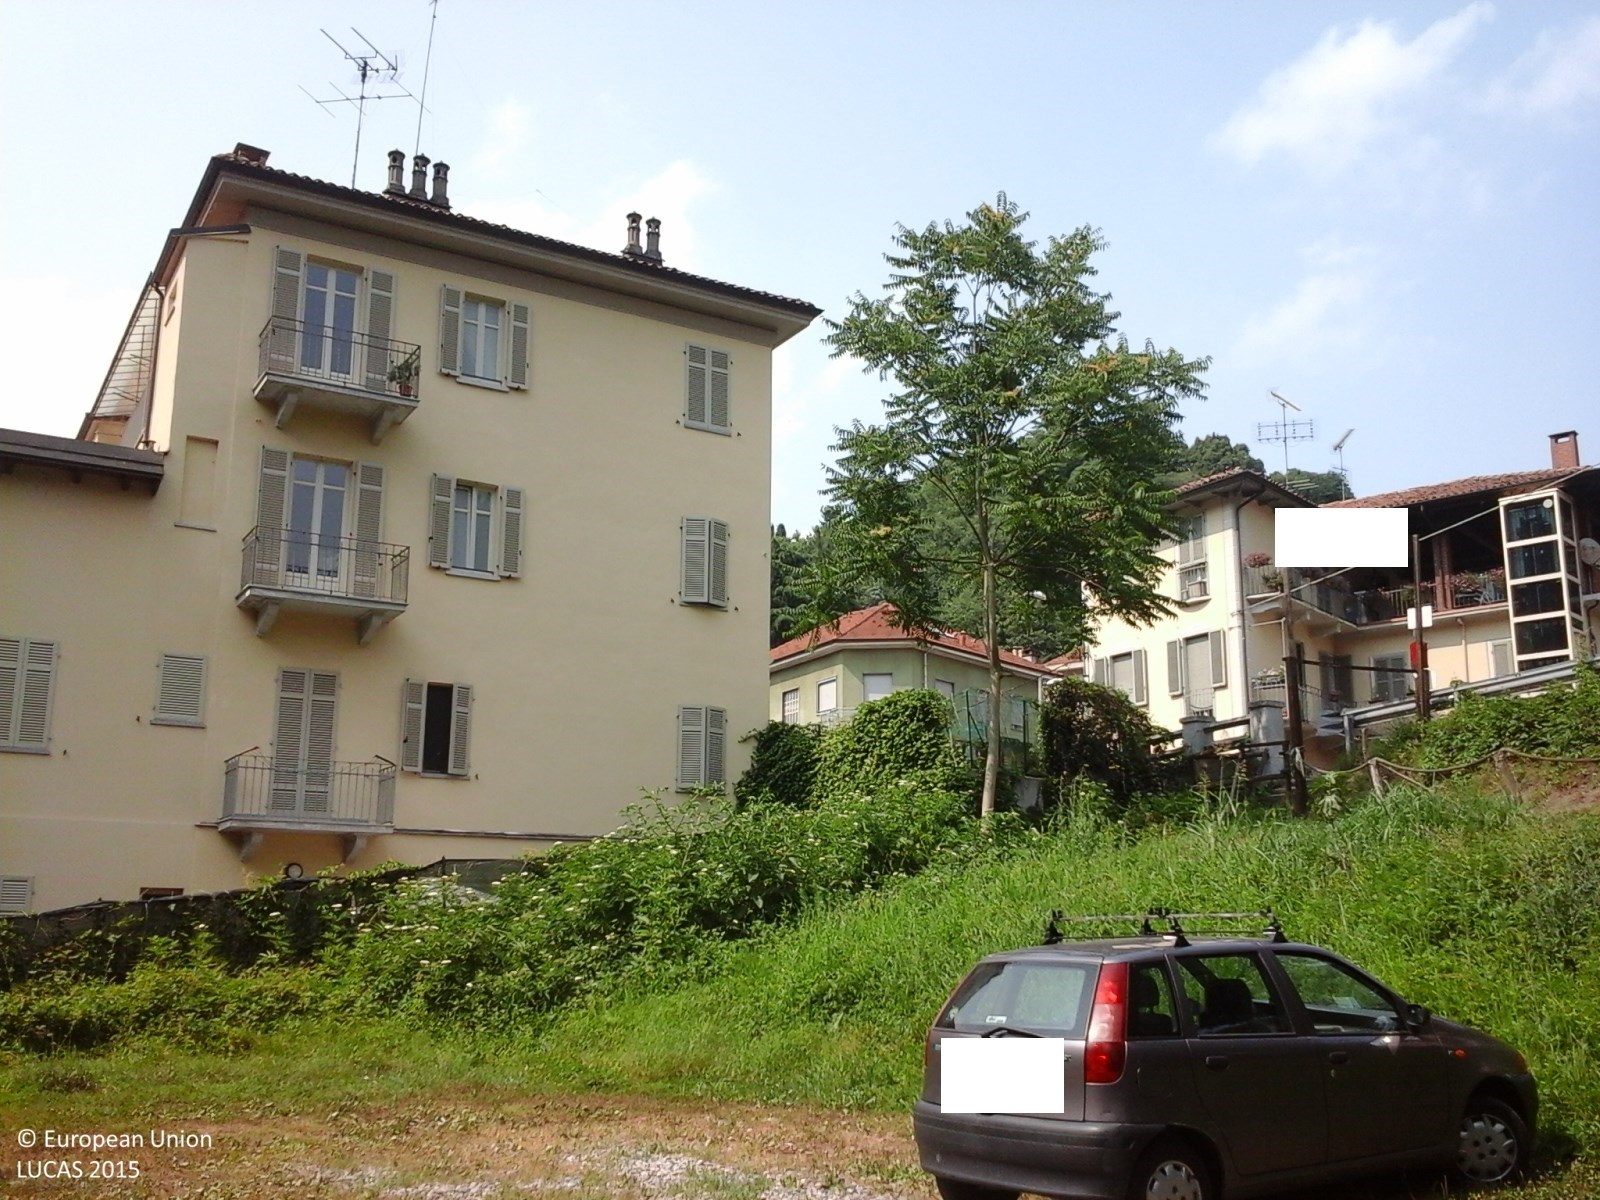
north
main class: Woodland
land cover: Broadleaved woodland
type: thermophilous deciduous forest
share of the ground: > 75 %
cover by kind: broadleaved forest trees 100 %
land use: Semi-natural and natural areas not in use
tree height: > 5 m
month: July
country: IT
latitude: 45.0653
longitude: 7.7307
